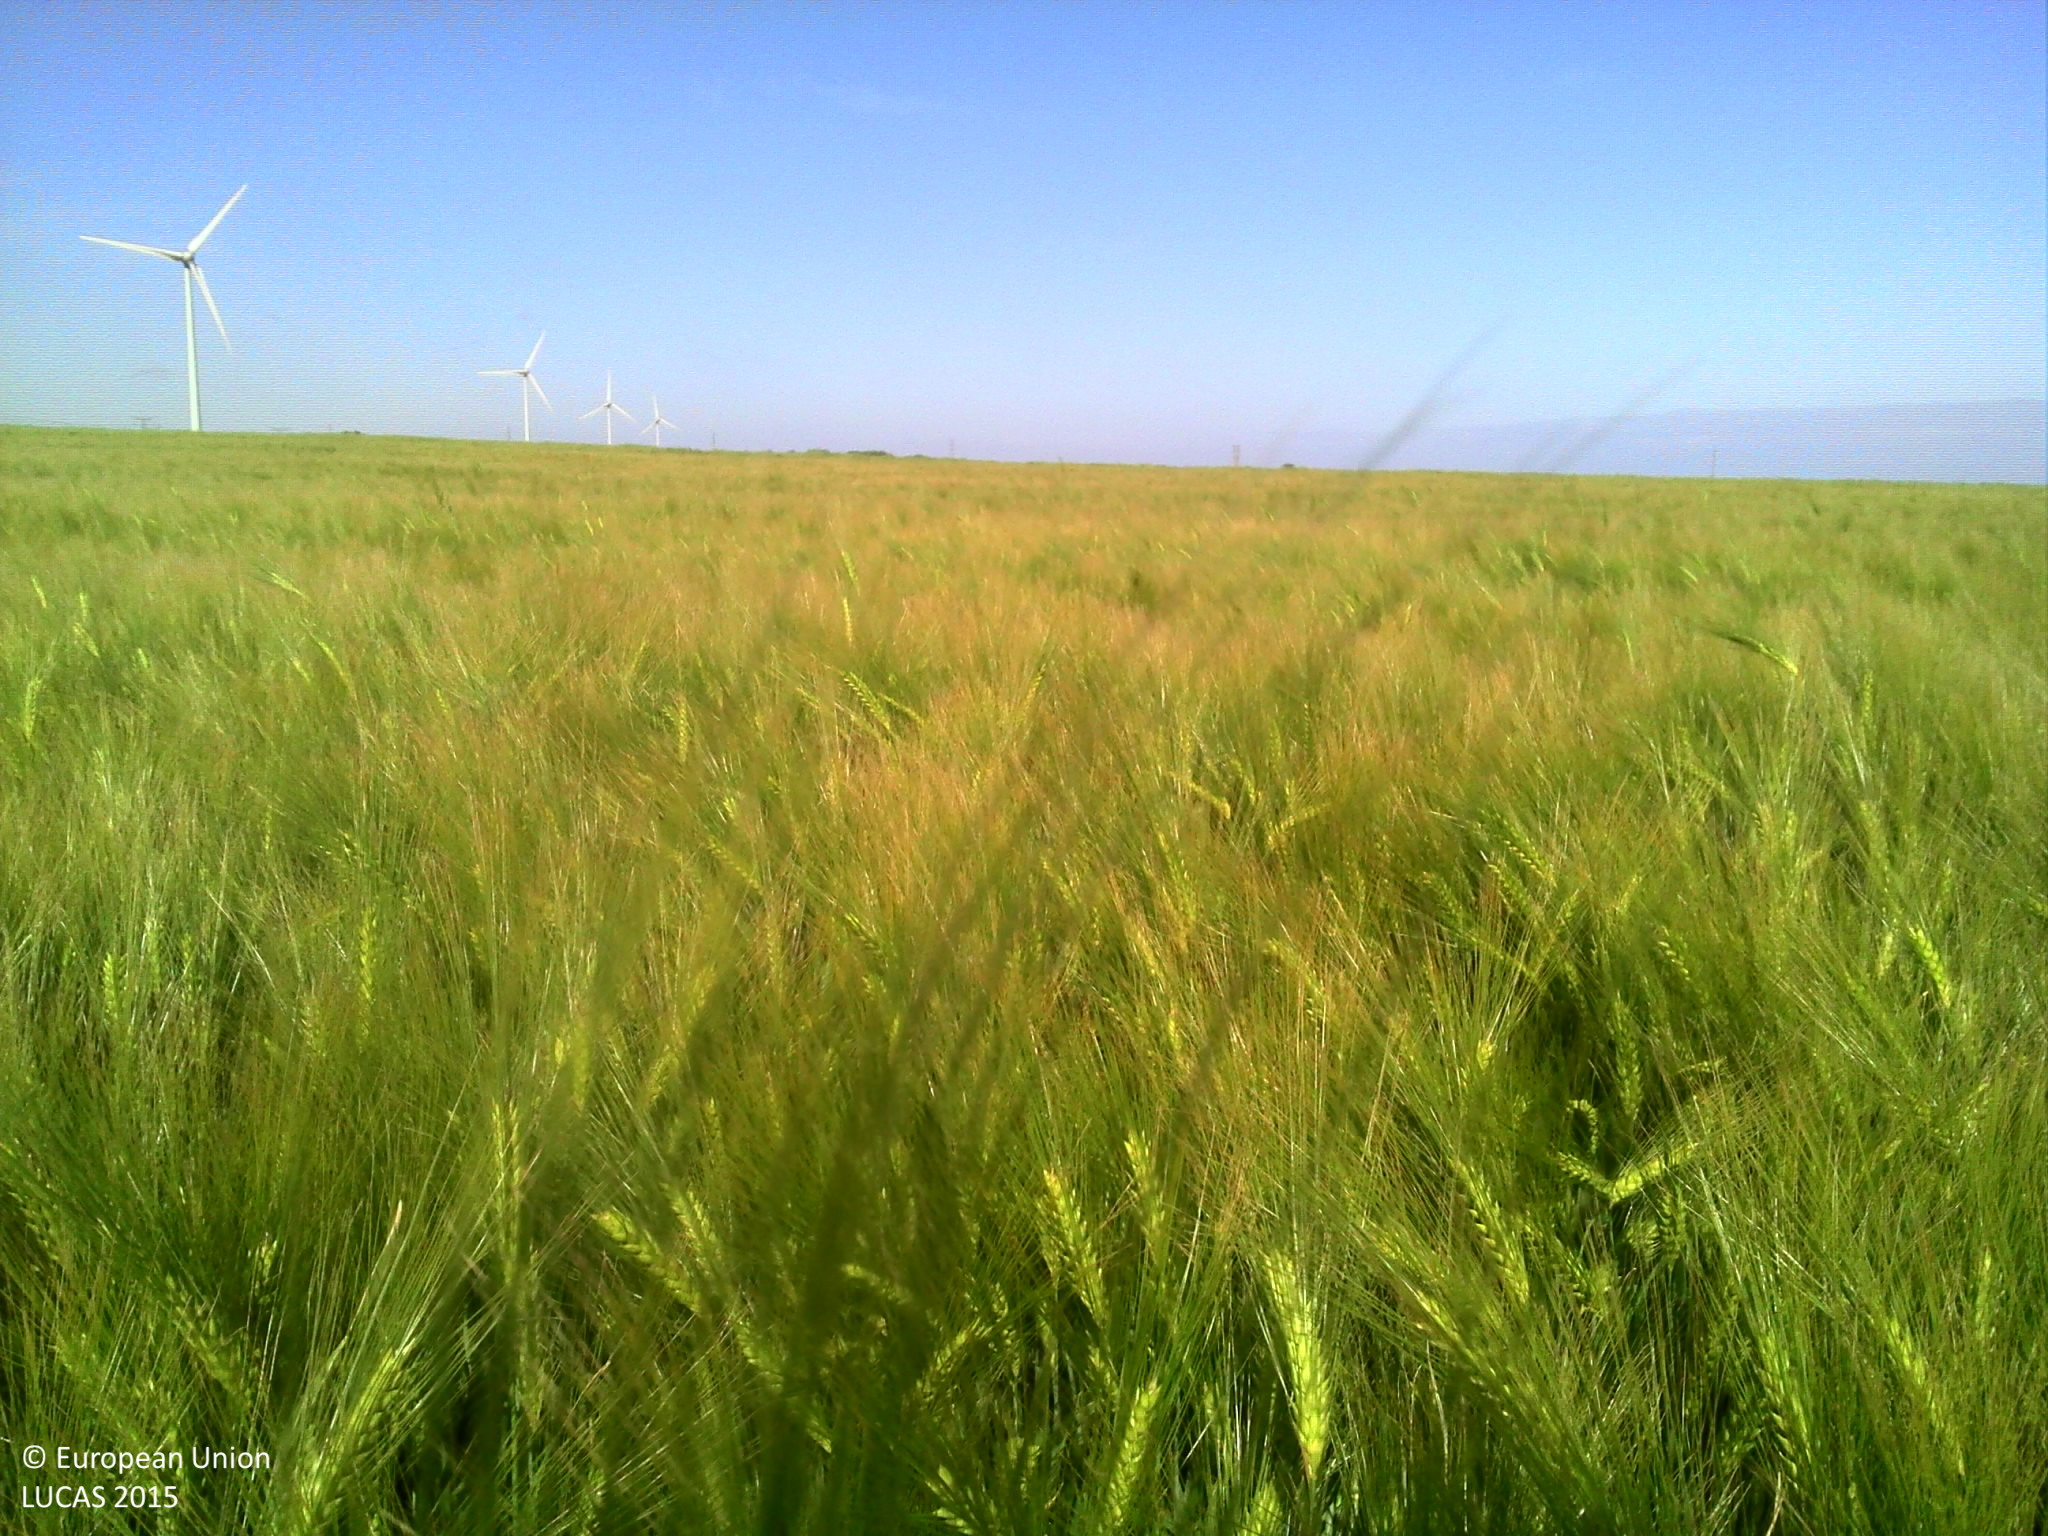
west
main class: Cropland
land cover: Barley
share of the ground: > 75 %
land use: Agriculture (excluding fallow land and kitchen gardens)
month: June
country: FR
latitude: 50.0538
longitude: 1.5877
